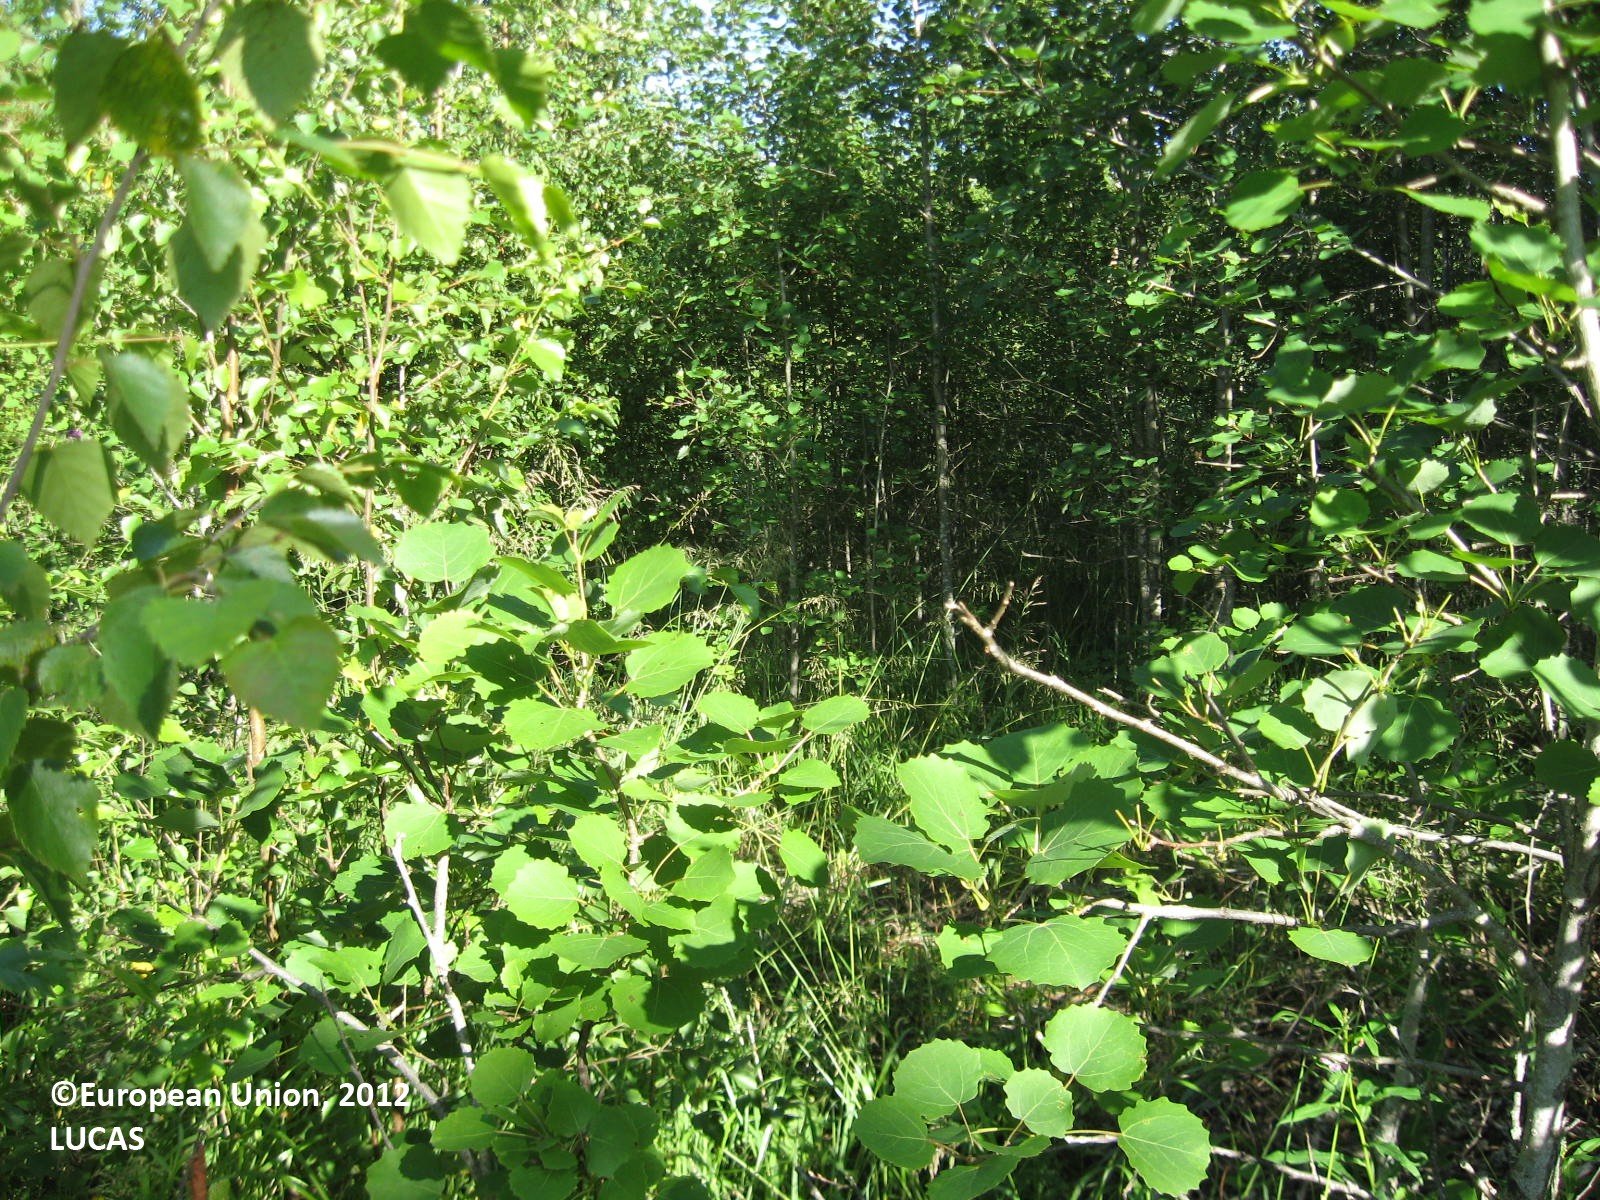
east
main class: Woodland
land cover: Broadleaved woodland
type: boreal forest
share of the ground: > 75 %
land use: Forestry
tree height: > 5 m
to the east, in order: Broadleaved woodland; Temporary grasslands; Grass margins; Ditches and canals; Shruby margins; Oats; Spruce dominated mixed woodland; Other bare soil; Oats; Grass margins; Ditches and canals; Spruce dominated coniferous woodland; Other mixed woodland; Spruce dominated coniferous woodland
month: July
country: FI
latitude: 62.1400
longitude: 21.4199
